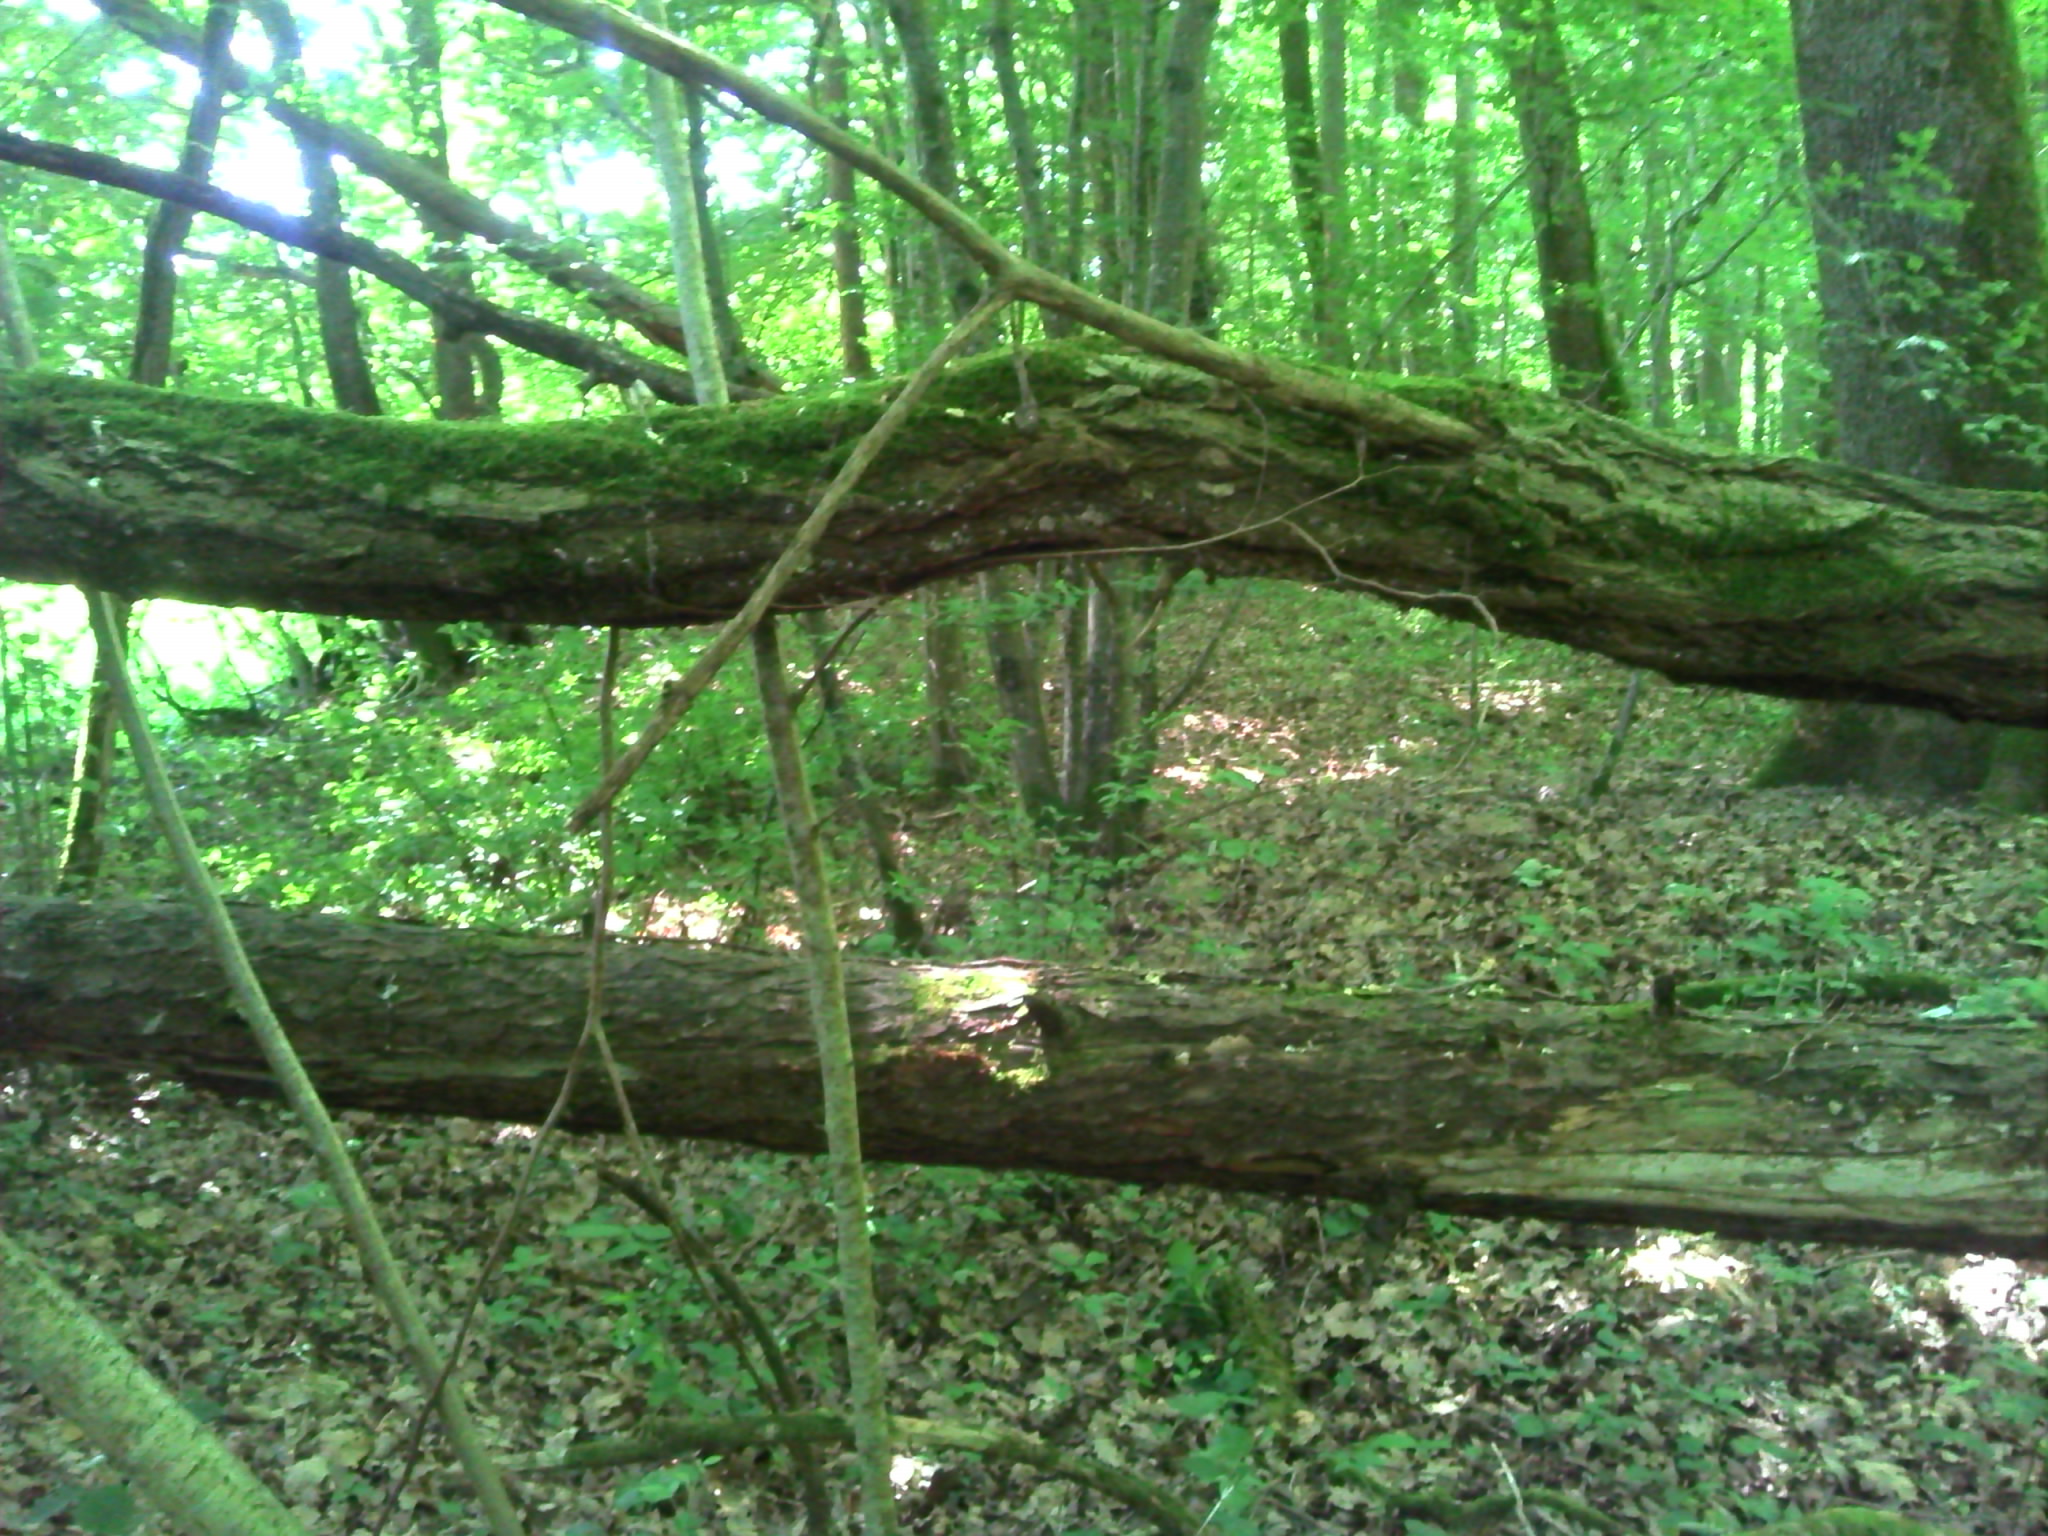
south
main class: Woodland
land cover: Broadleaved woodland
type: mesophytic deciduous forest
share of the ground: > 75 %
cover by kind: broadleaved forest trees 90 %, herbaceous plants 10 %
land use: Forestry
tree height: > 5 m
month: May
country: FR
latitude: 46.4993
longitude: 5.2725
